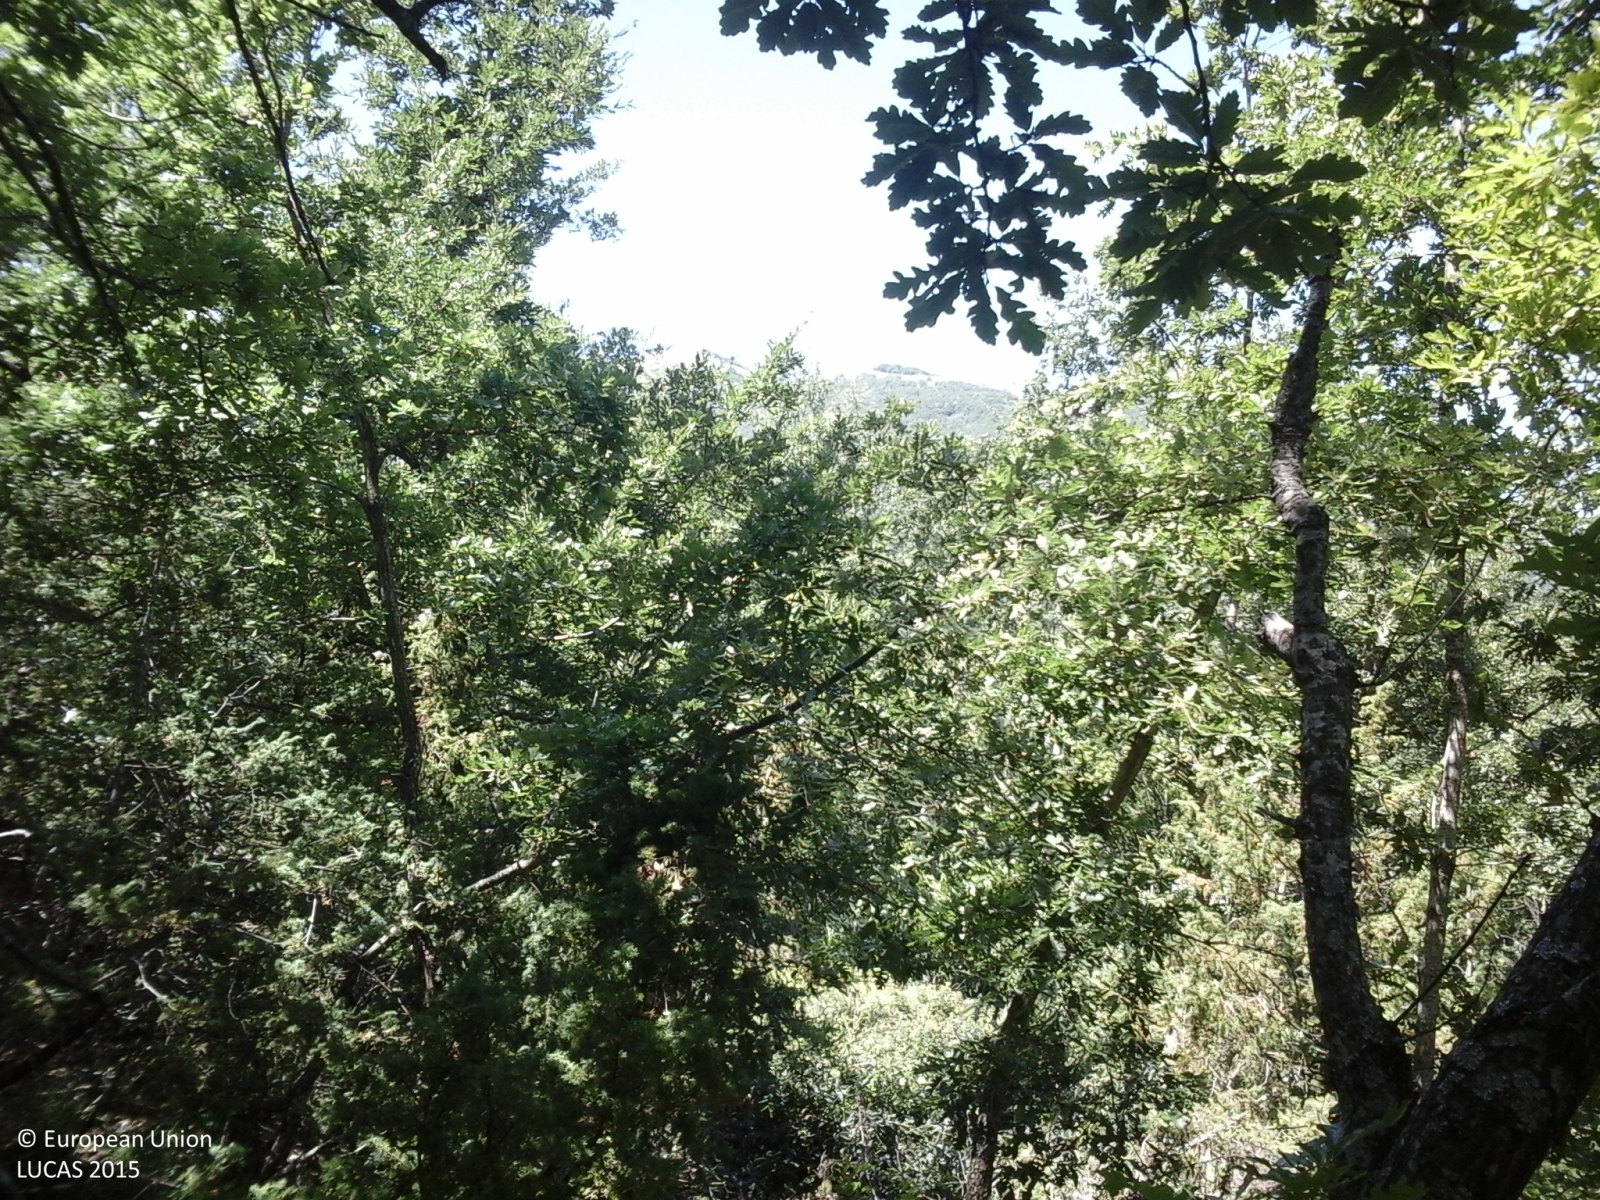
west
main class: Woodland
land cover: Broadleaved woodland
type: thermophilous deciduous forest
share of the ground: > 75 %
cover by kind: broadleaved forest trees 100 %
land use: Forestry
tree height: > 5 m
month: June
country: IT
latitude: 42.7284
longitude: 13.2512
